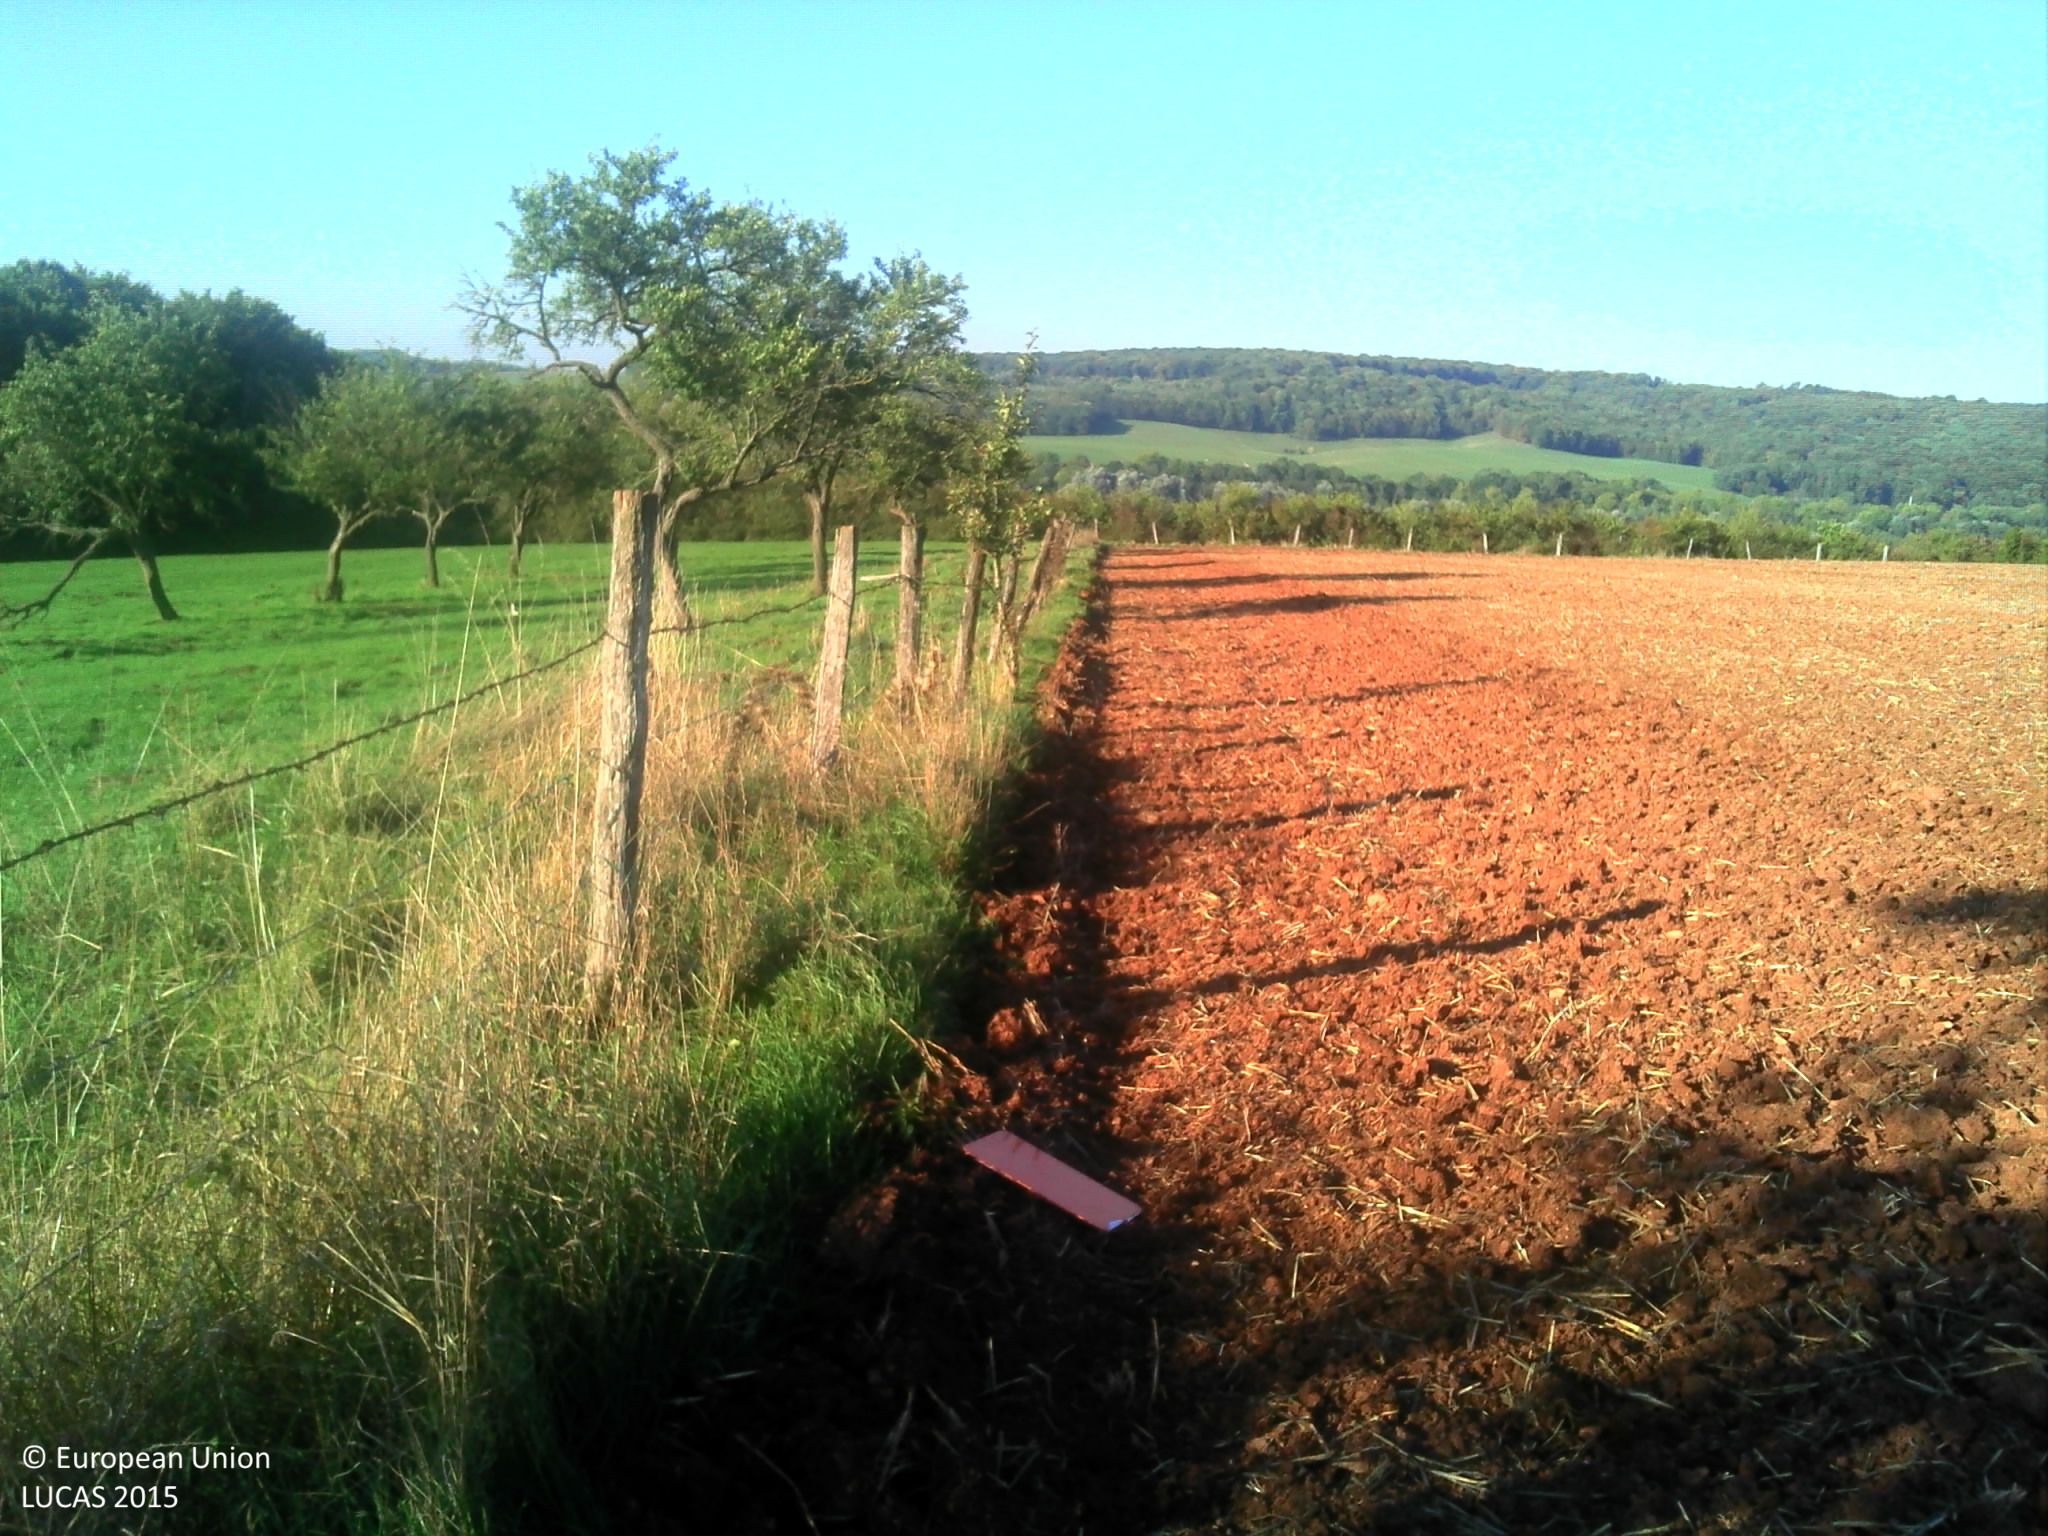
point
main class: Cropland
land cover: Common wheat
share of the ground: < 10 %
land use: Agriculture (excluding fallow land and kitchen gardens)
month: October
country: FR
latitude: 48.5389
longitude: 6.2756
